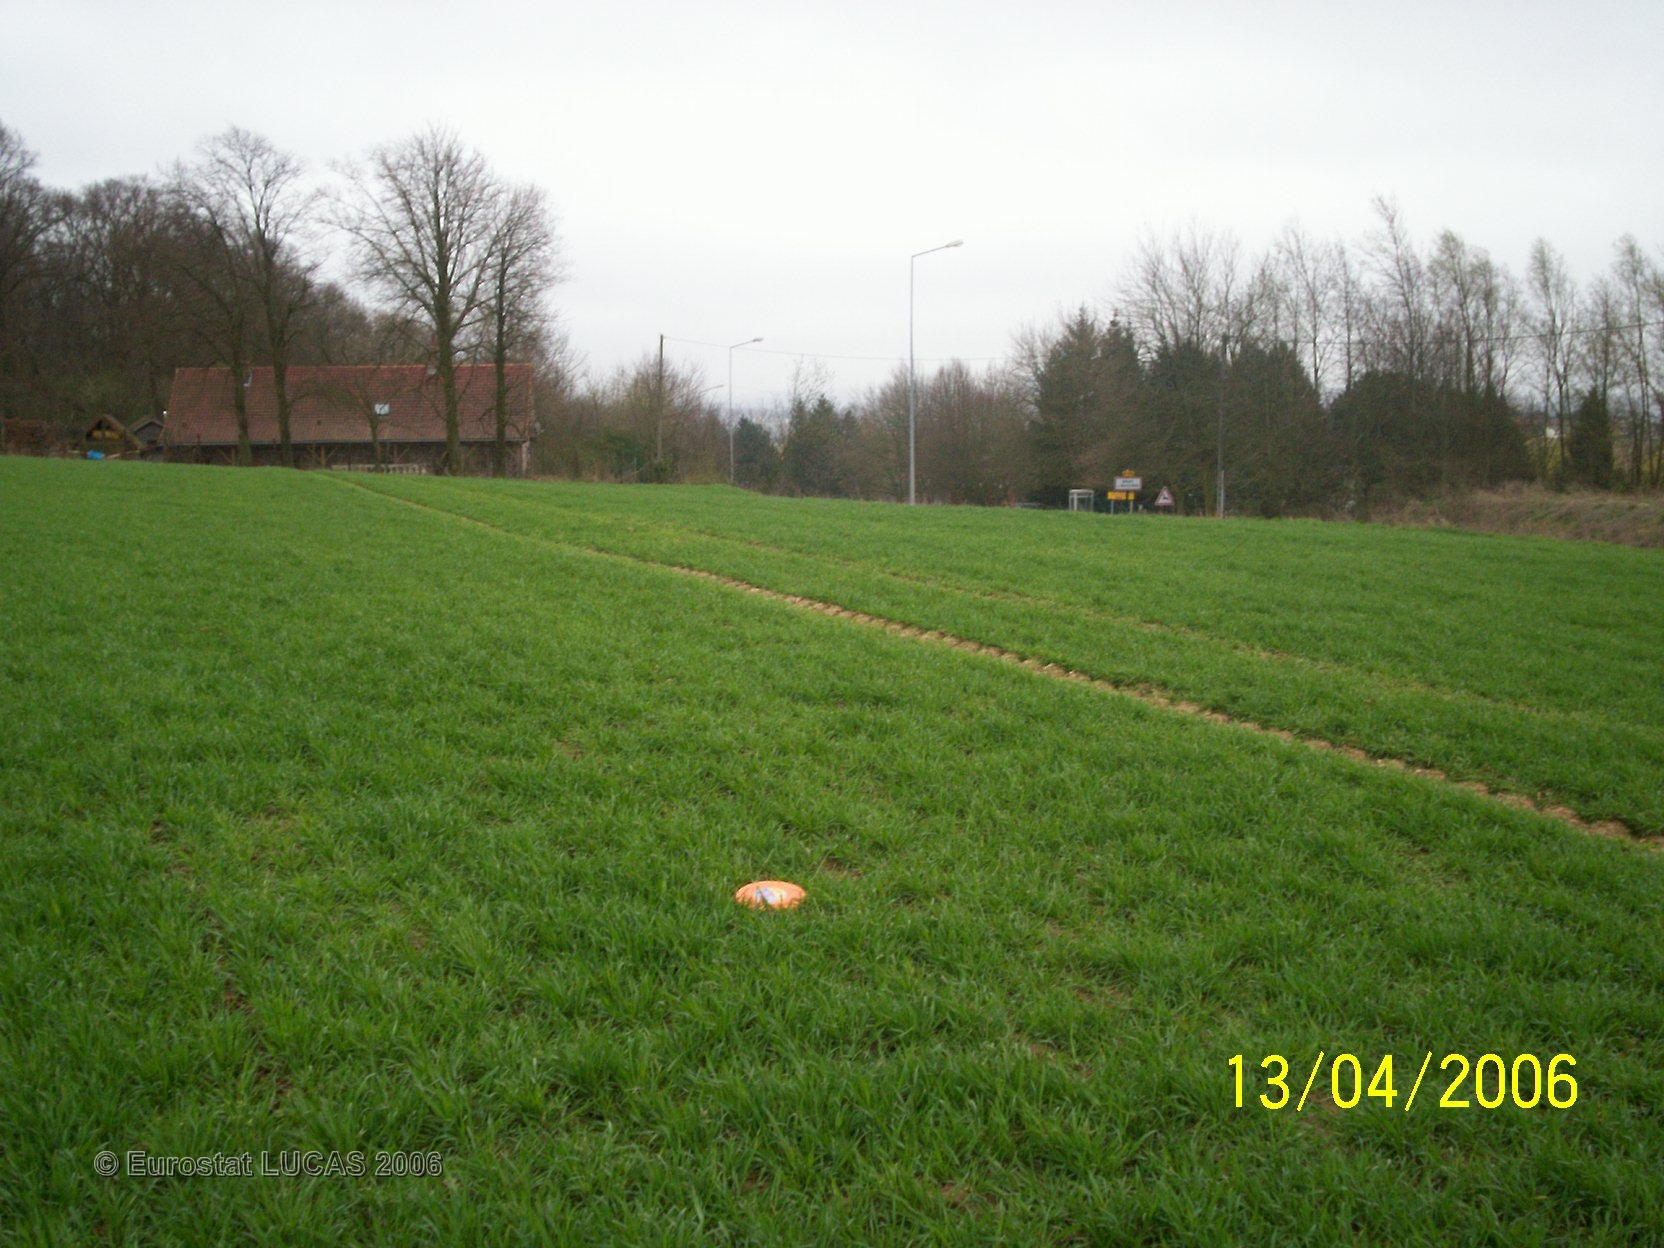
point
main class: Cropland
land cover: Common wheat
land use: Agriculture (excluding fallow land and kitchen gardens)
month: April
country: FR
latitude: 50.4988
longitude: 2.5297
